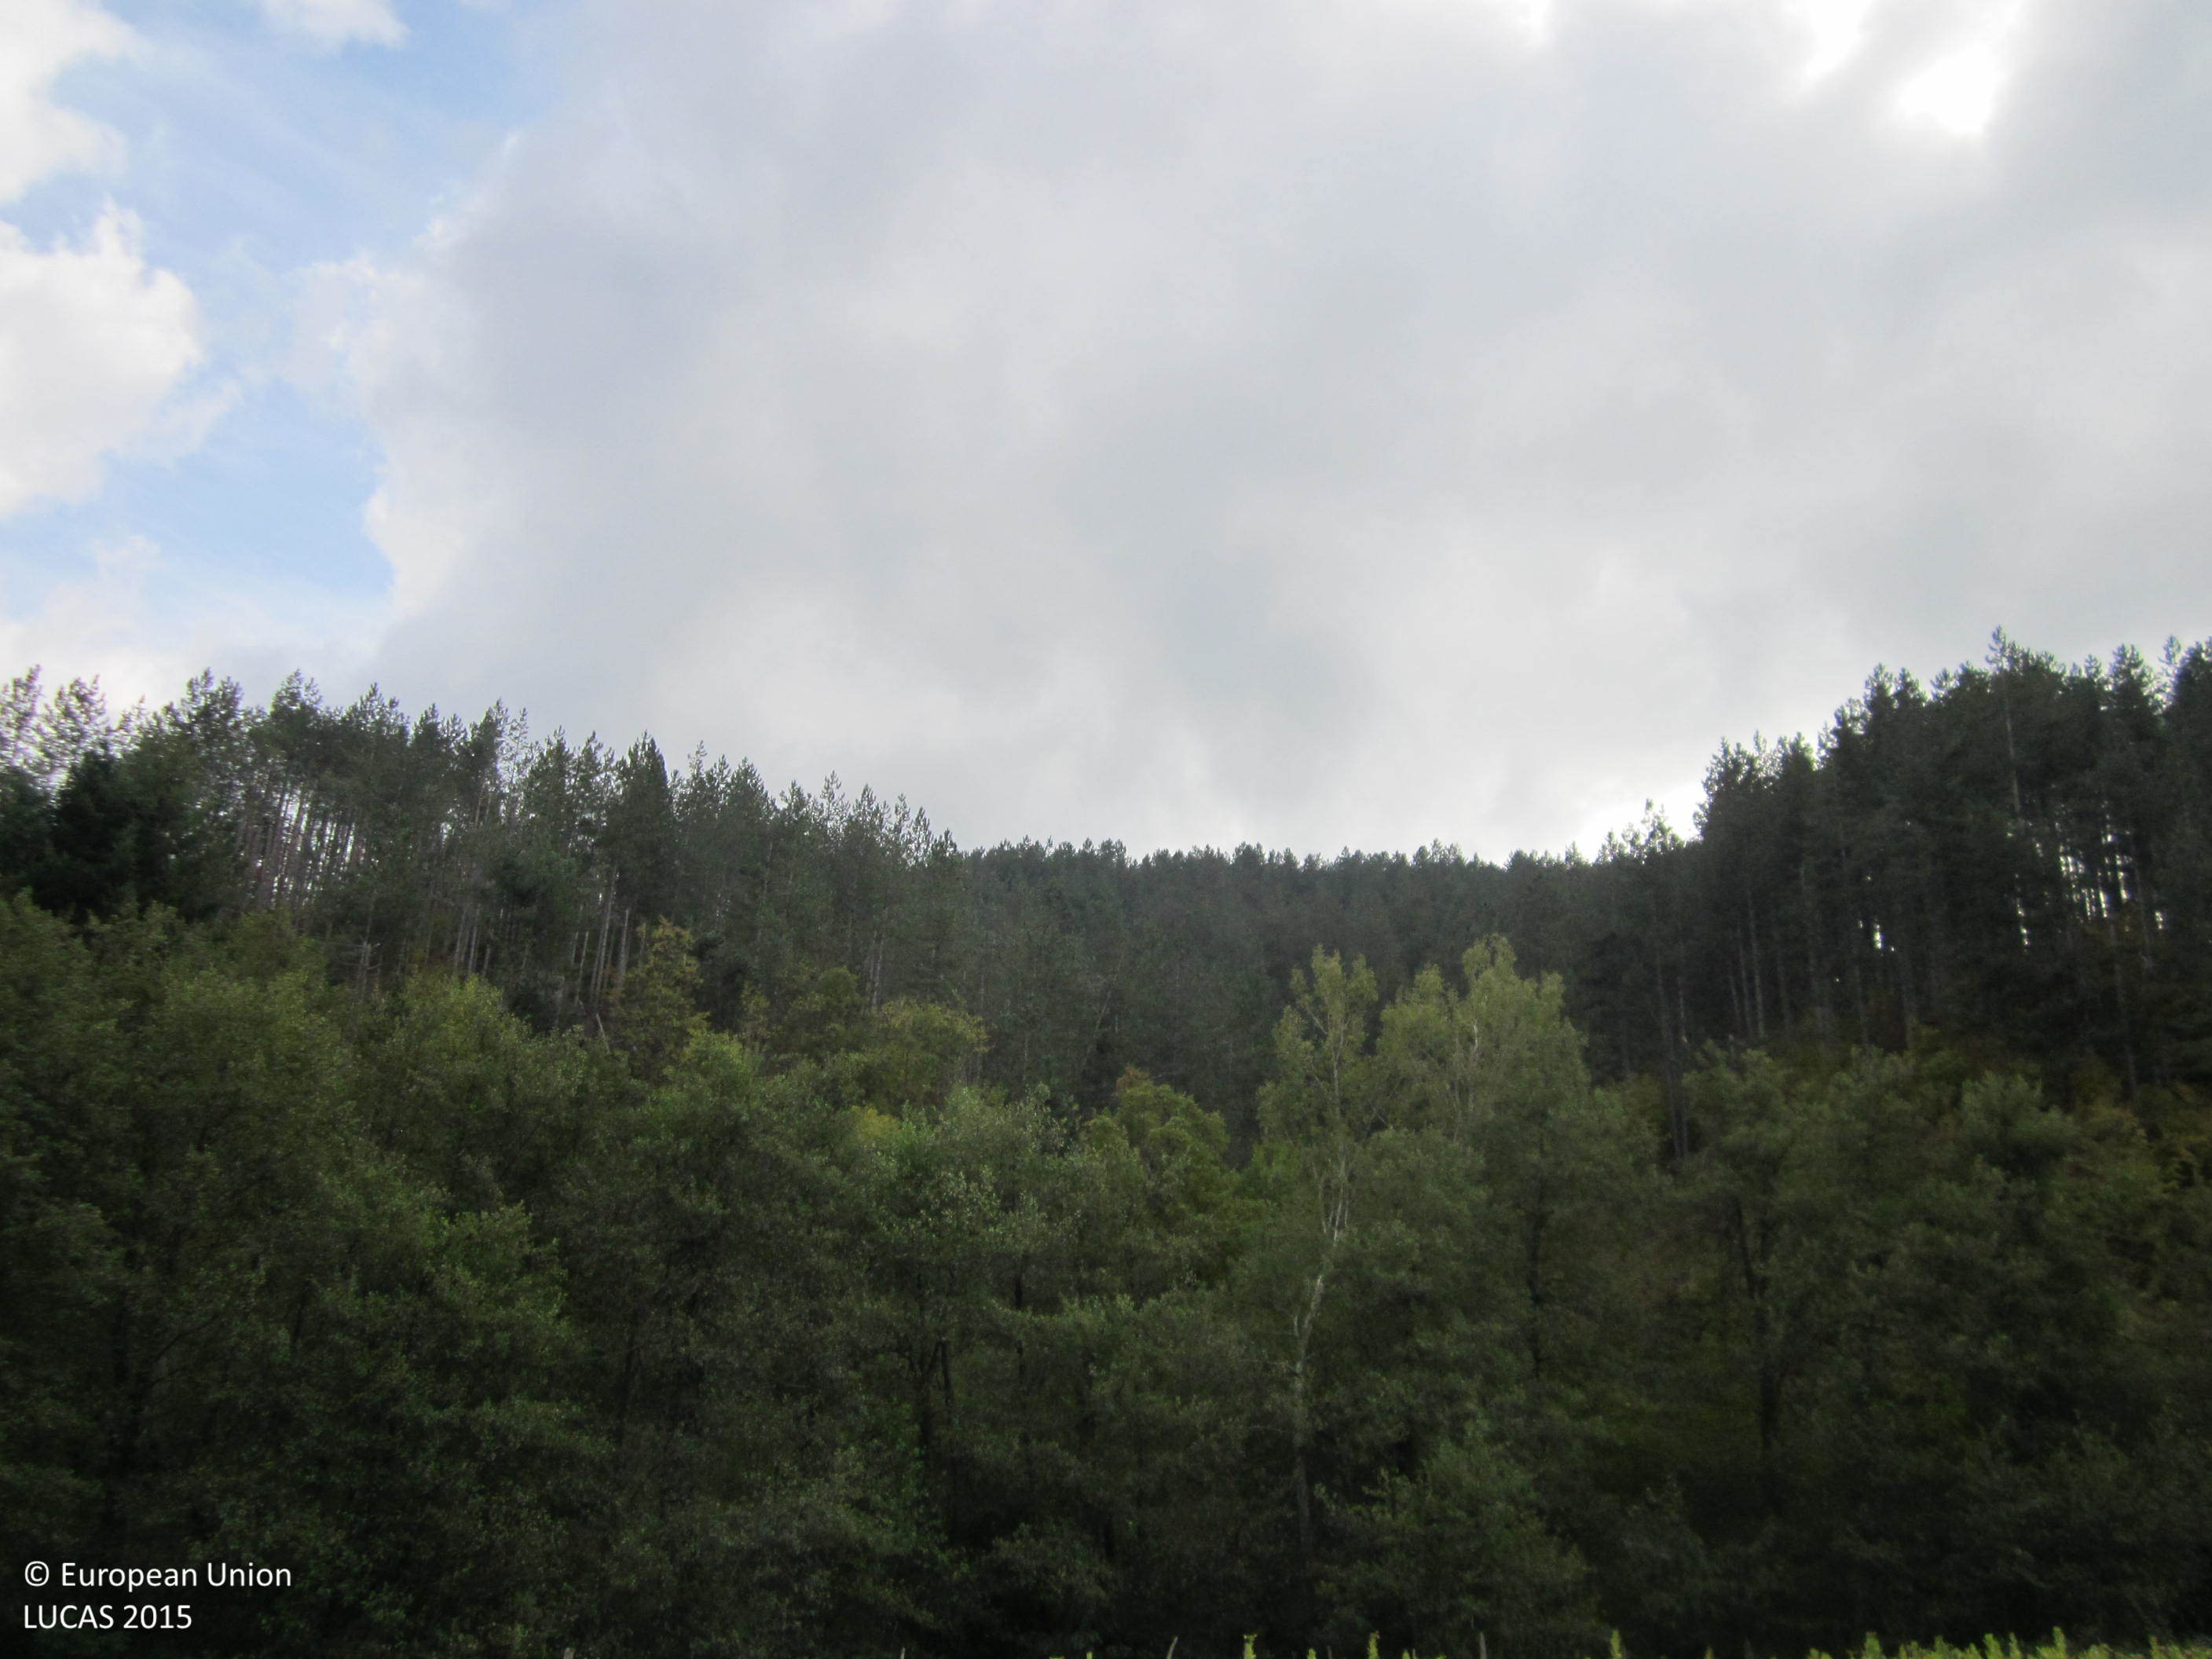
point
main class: Woodland
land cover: Pine dominated coniferous woodland
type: hemiboreal forest and nemoral coniferous forest and mixed broadleaved-coniferous forest
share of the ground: > 75 %
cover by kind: coniferous forest trees 100 %
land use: Forestry
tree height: > 5 m
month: October
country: BG
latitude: 41.3727
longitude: 25.5398
